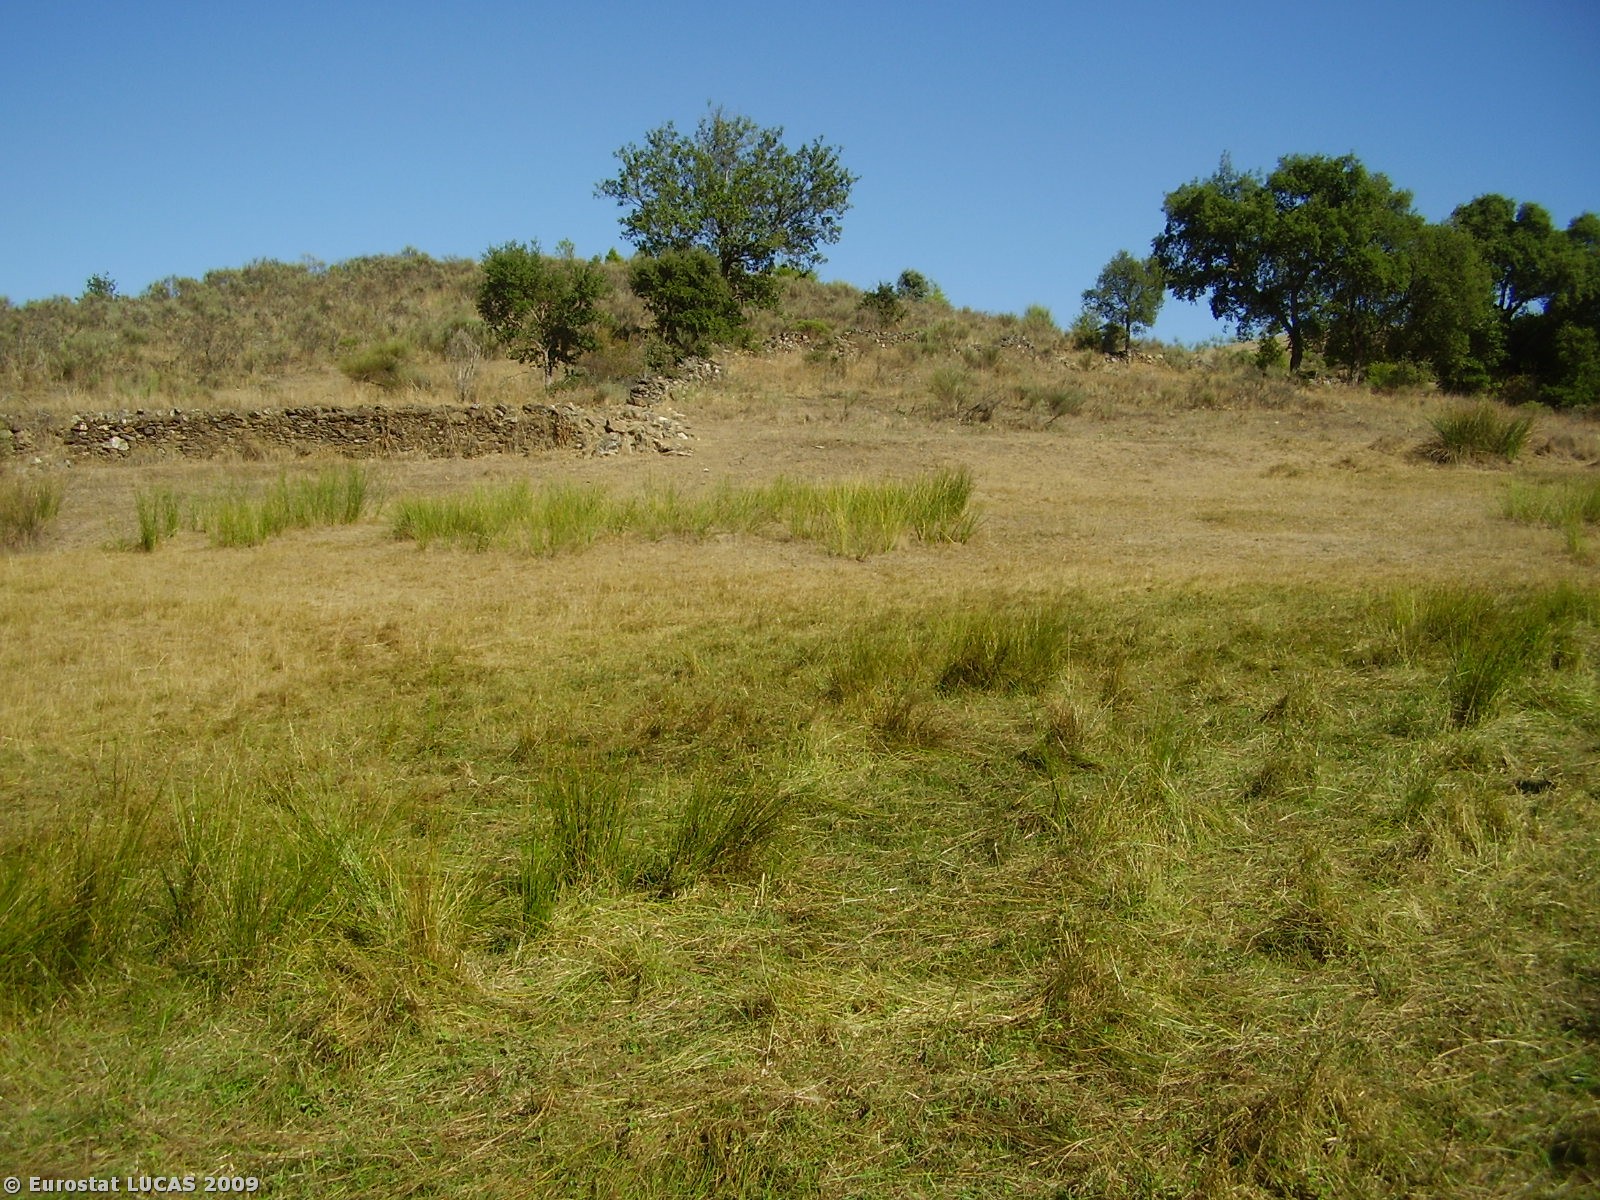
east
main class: Grassland
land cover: Spontaneously vegetated surfaces
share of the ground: > 75 %
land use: Fallow land
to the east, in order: Spontaneously vegetated surfaces; Dry stone walls; Single bushes/trees; Spontaneously vegetated surfaces; Tracks; Shrubland without tree cover; Broadleaved woodland; Electric lines; Broadleaved woodland; Fences; Olive groves
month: August
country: PT
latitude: 41.2784
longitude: -6.7846
